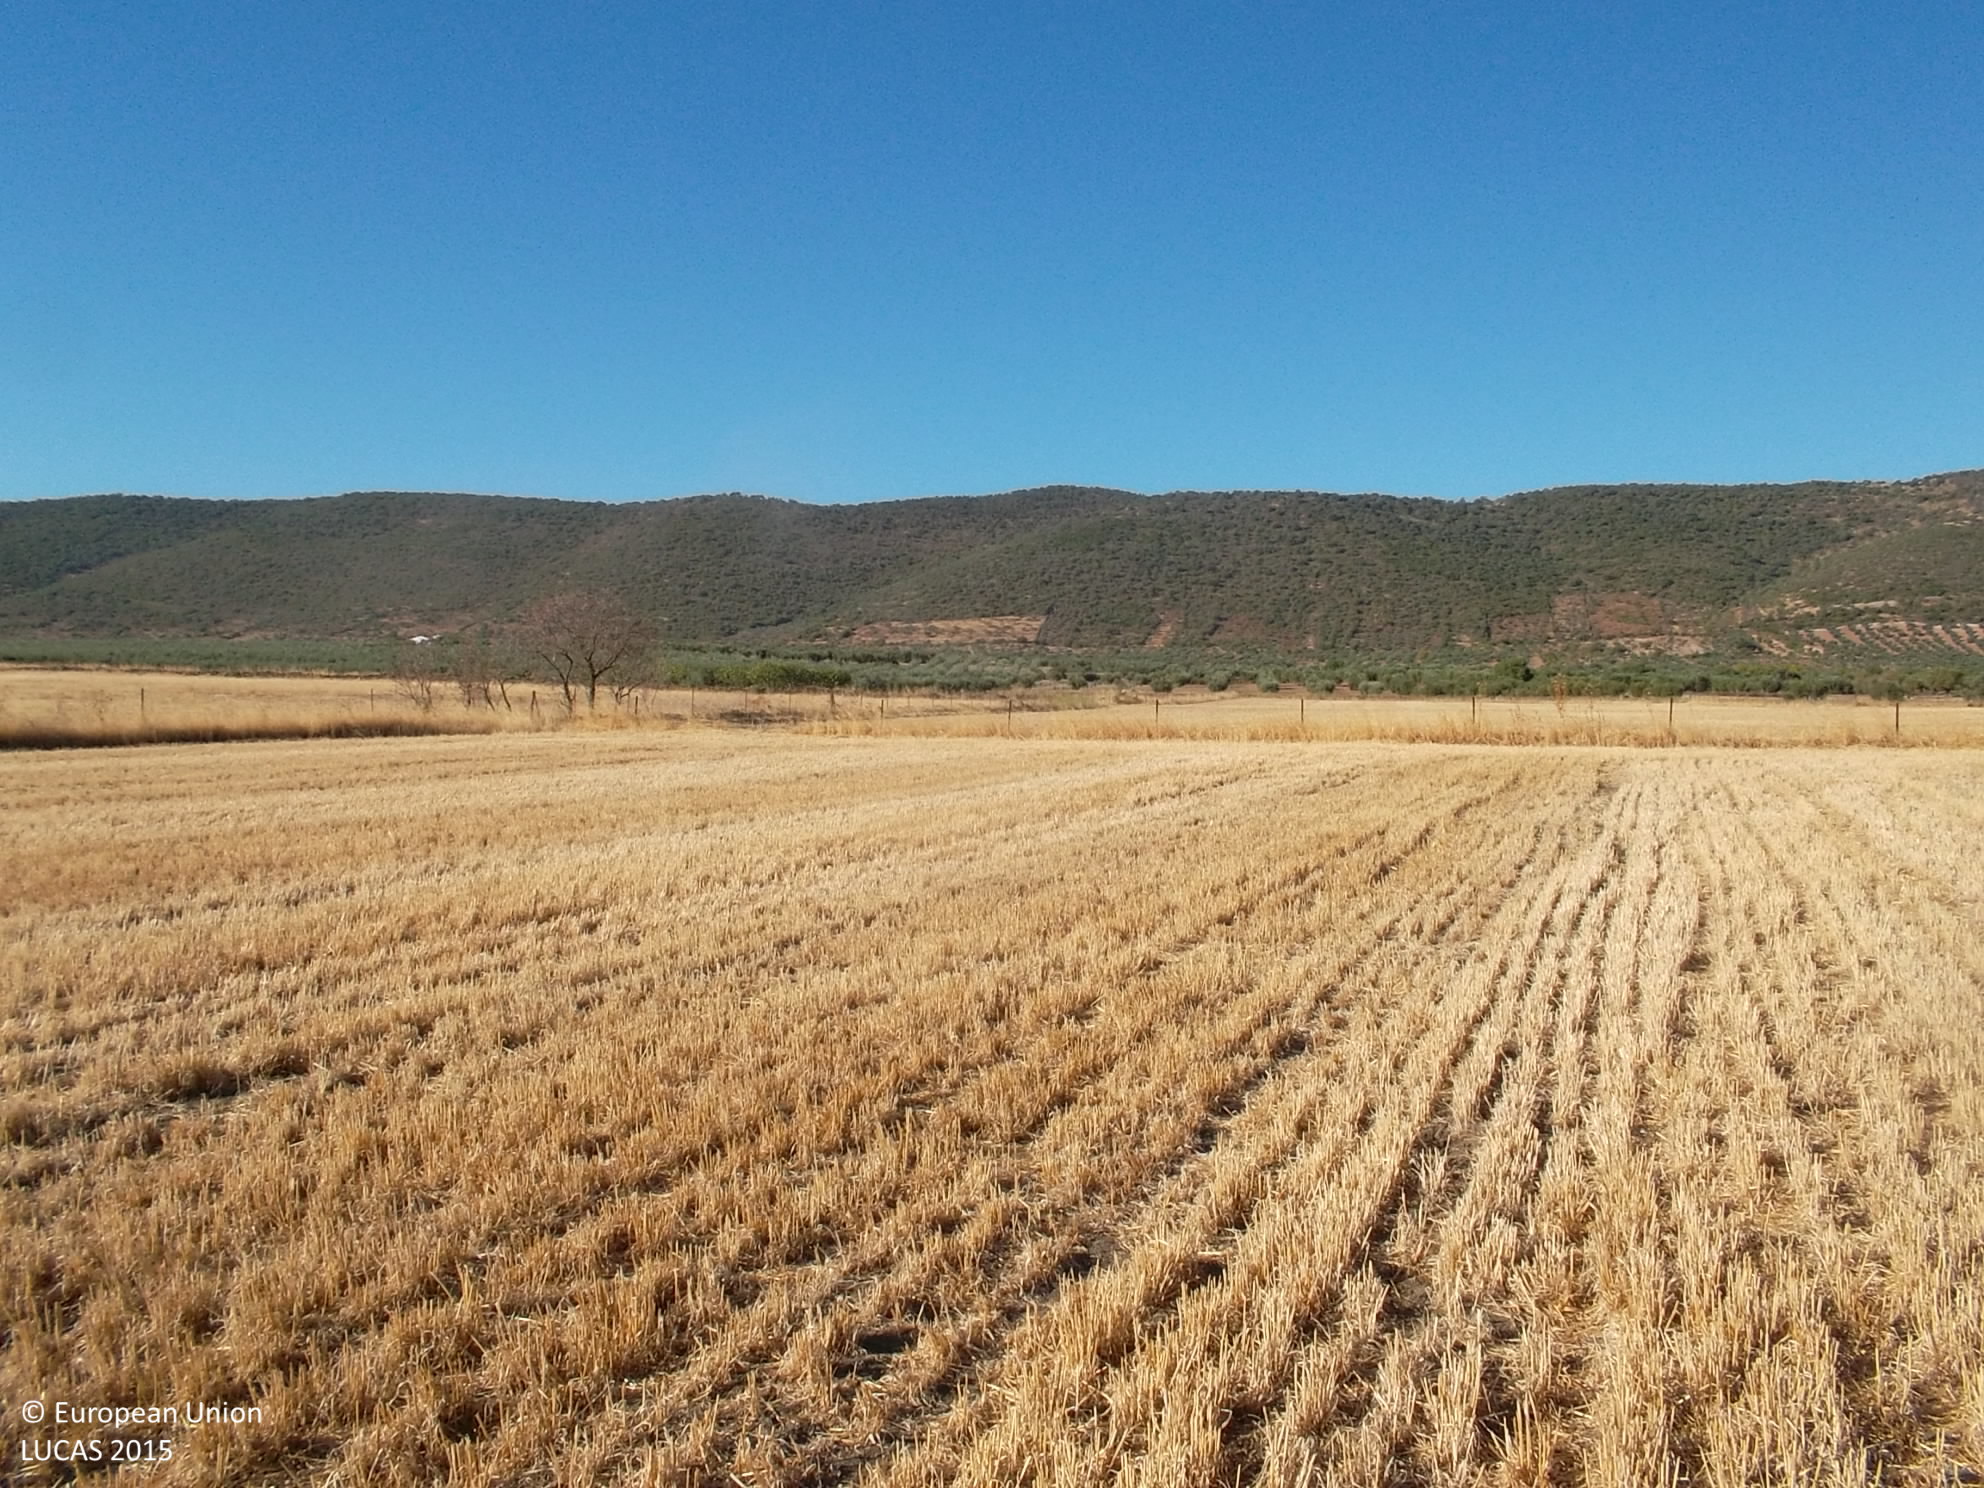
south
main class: Cropland
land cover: Mixed cereals for fodder
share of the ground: < 10 %
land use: Agriculture (excluding fallow land and kitchen gardens)
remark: Harvested field
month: August
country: ES
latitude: 38.5547
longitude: -6.6619
